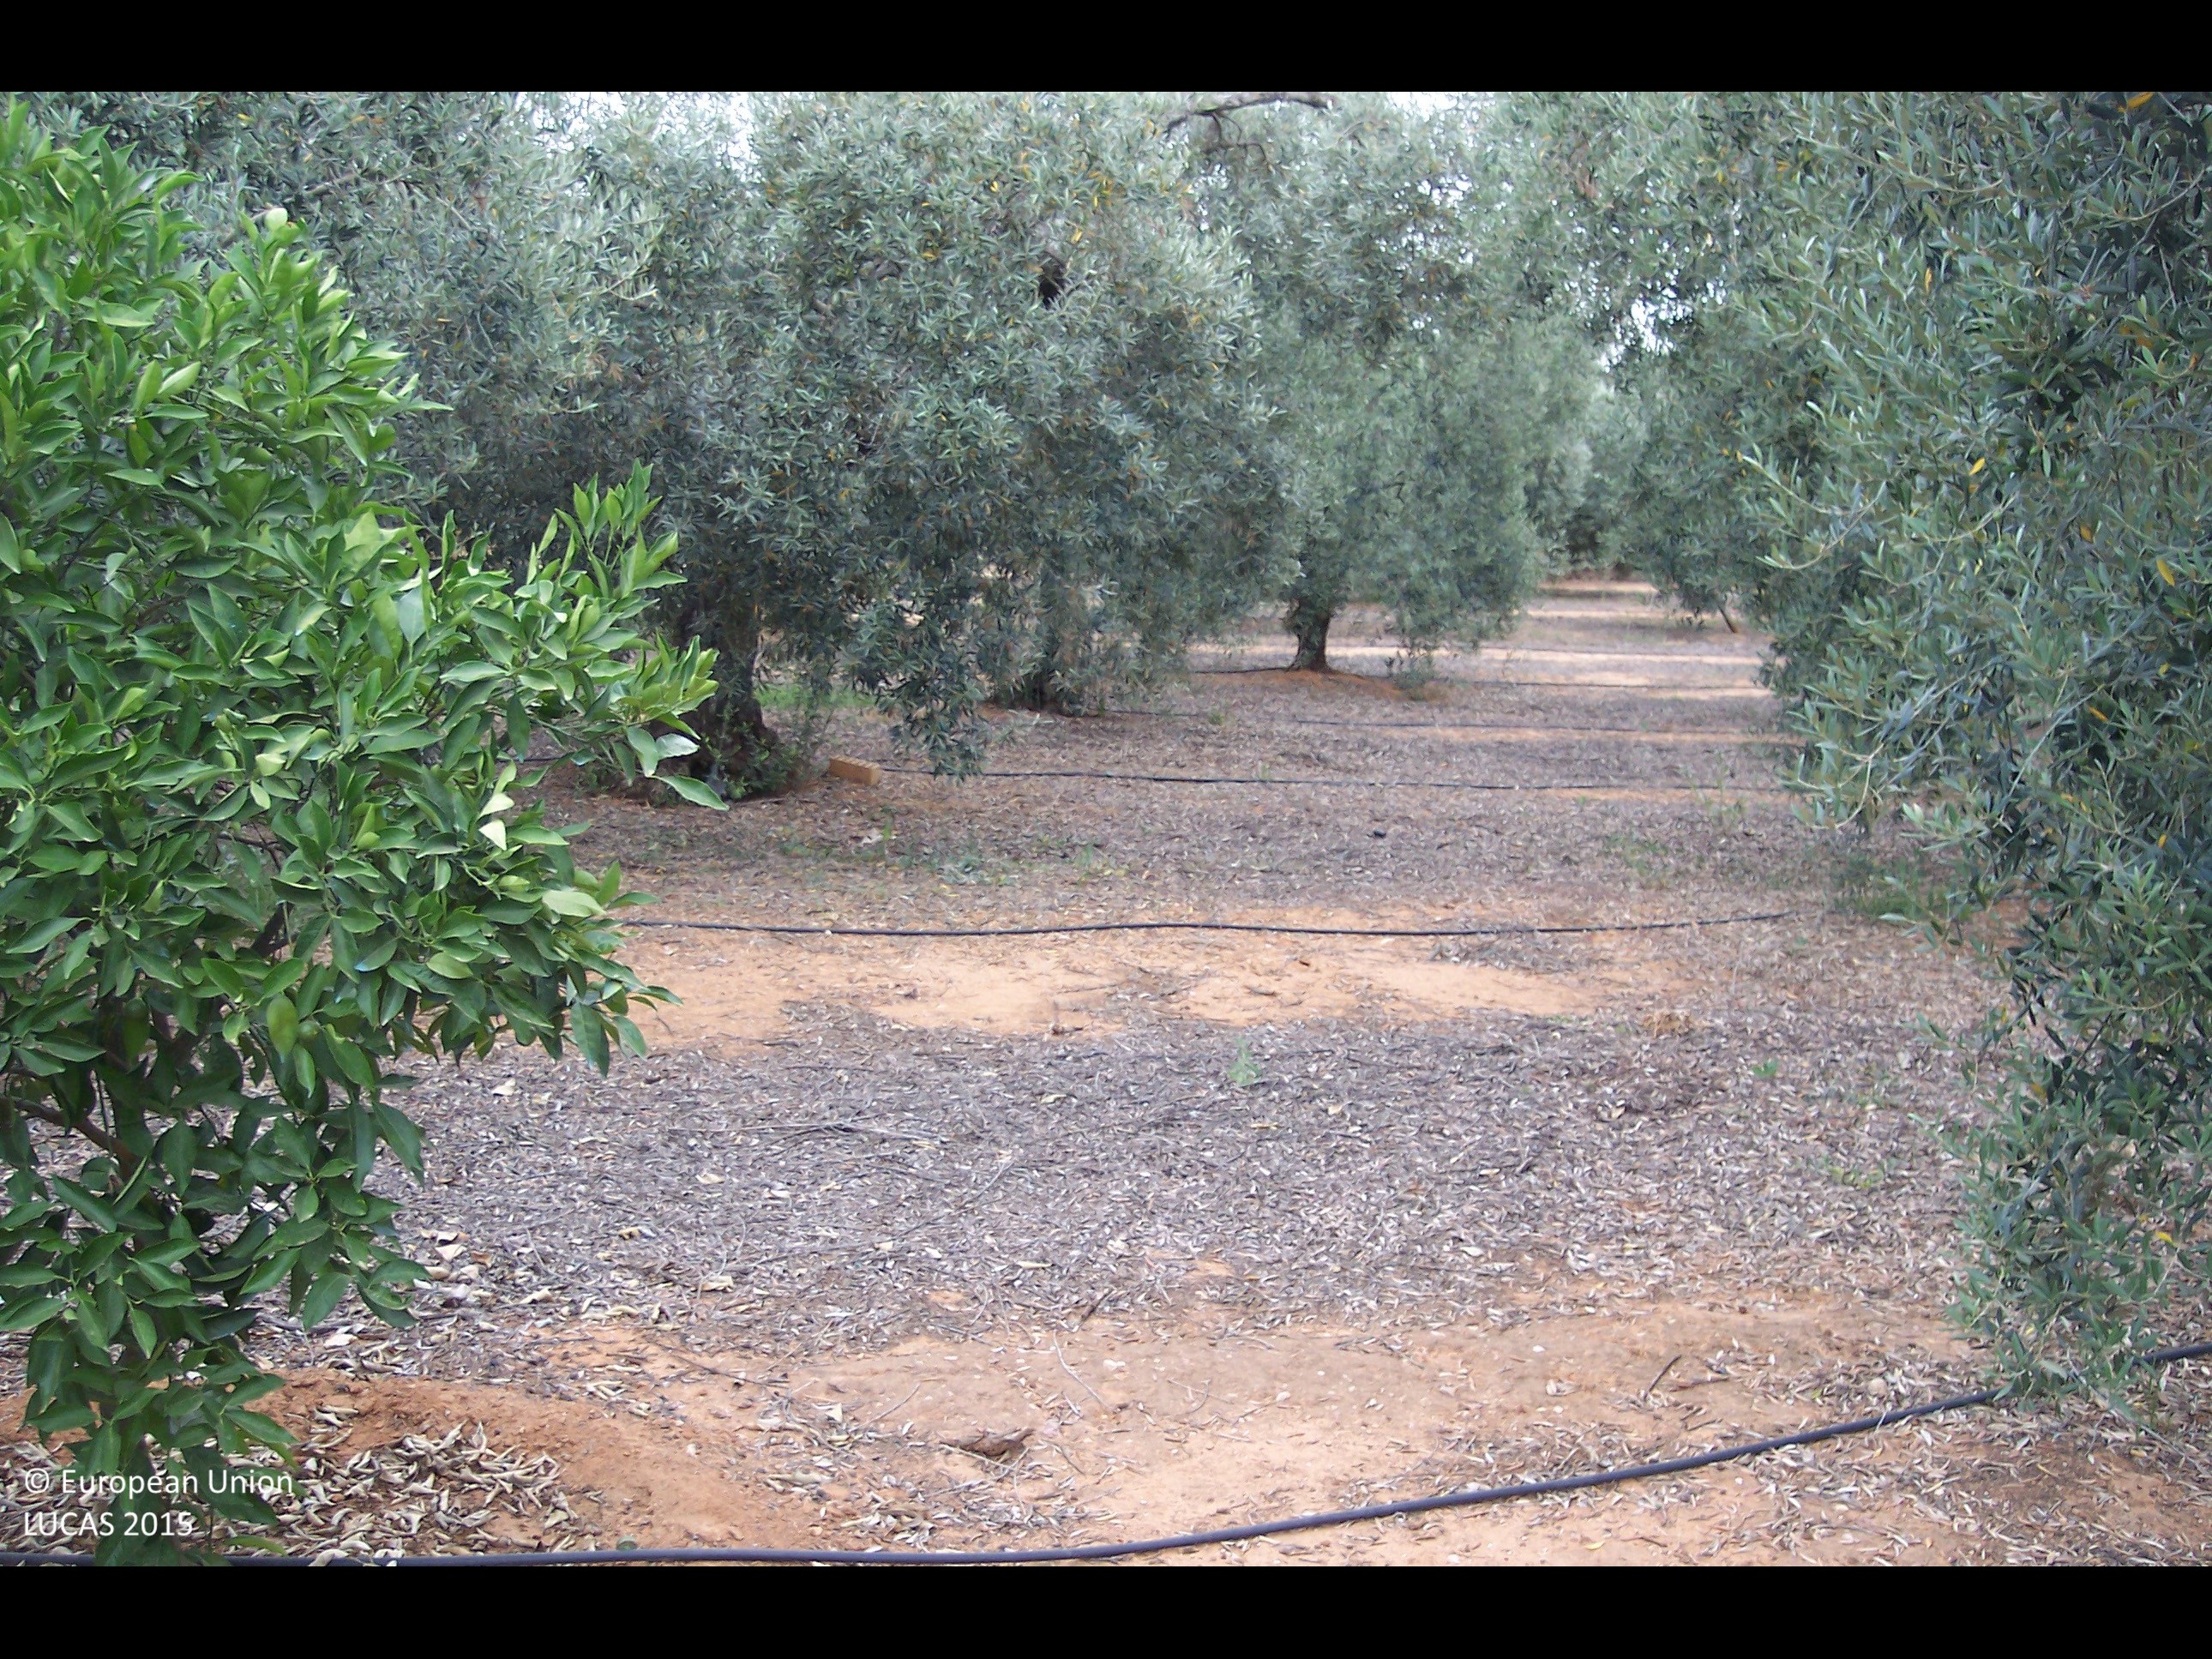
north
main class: Cropland
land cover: Olive groves
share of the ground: 25 - 50 %
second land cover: Oranges
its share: 25 - 50 %
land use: Agriculture (excluding fallow land and kitchen gardens)
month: June
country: ES
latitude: 37.3164
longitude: -6.1497
